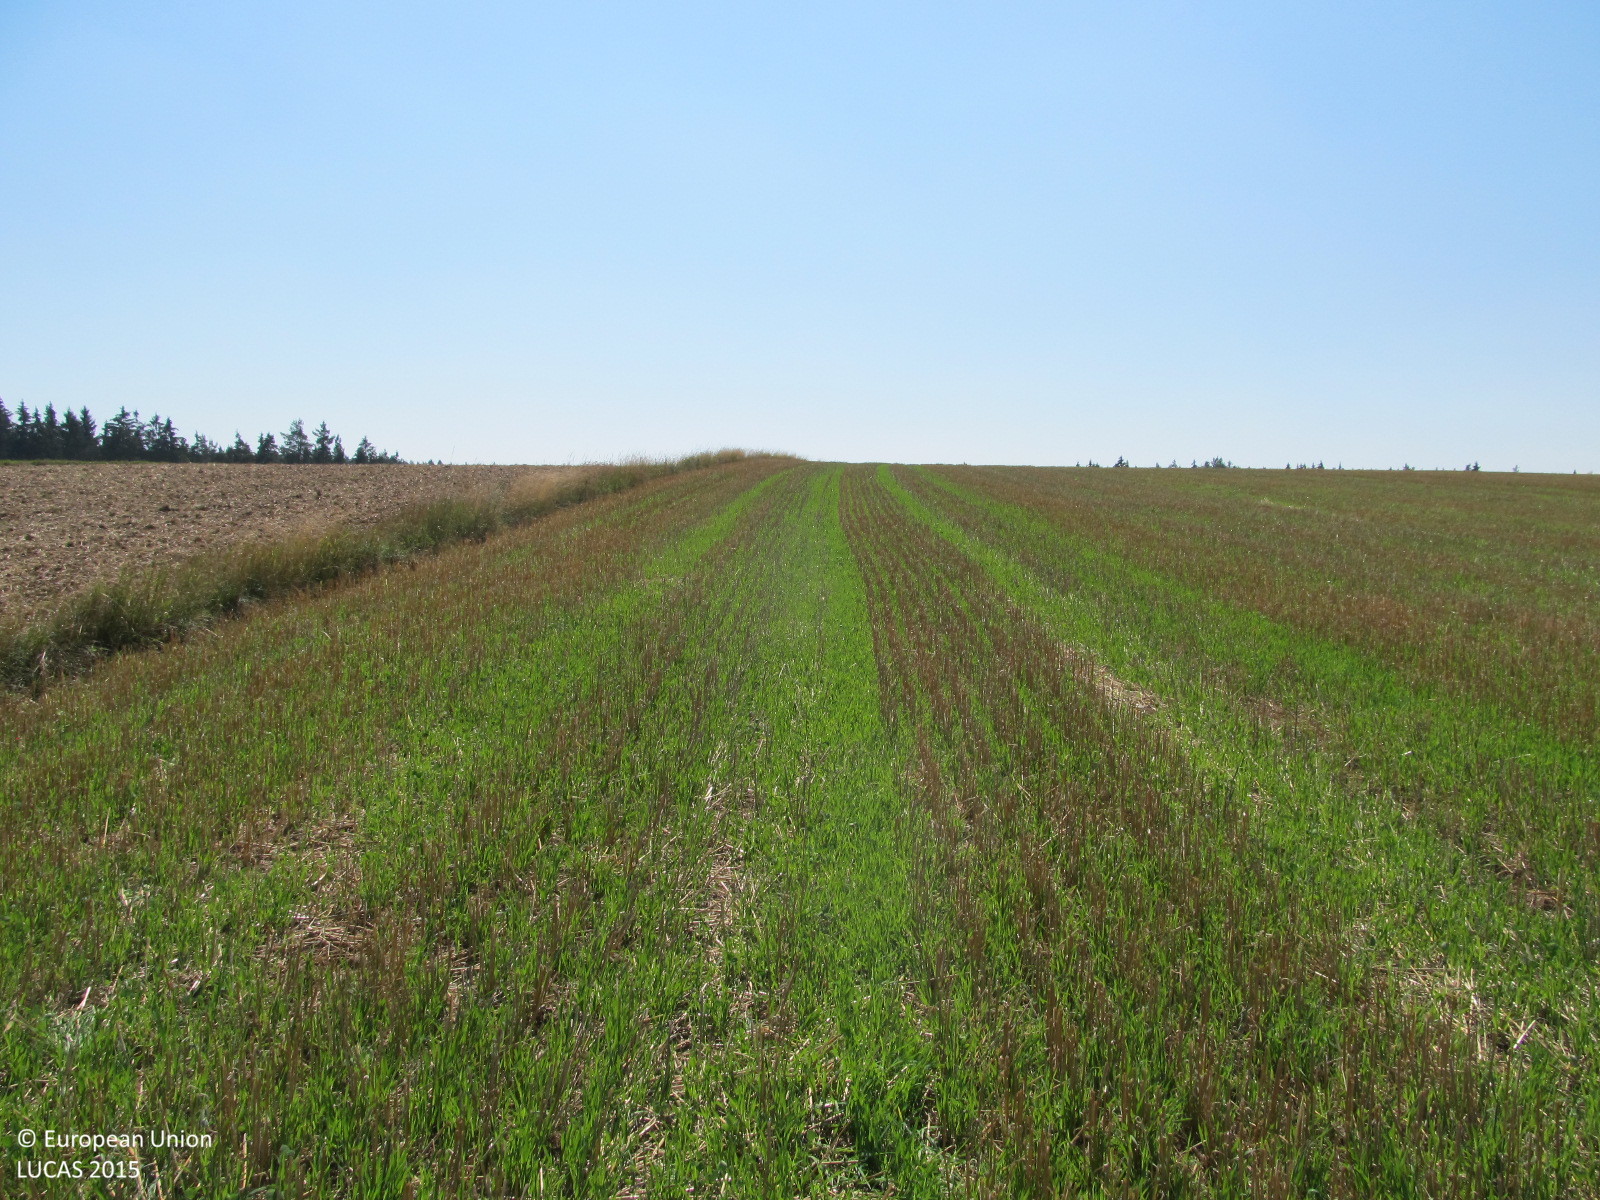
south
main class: Cropland
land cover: Common wheat
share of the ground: 50 - 75 %
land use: Agriculture (excluding fallow land and kitchen gardens)
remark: Harvested field
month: August
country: AT
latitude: 48.8260
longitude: 15.4926
